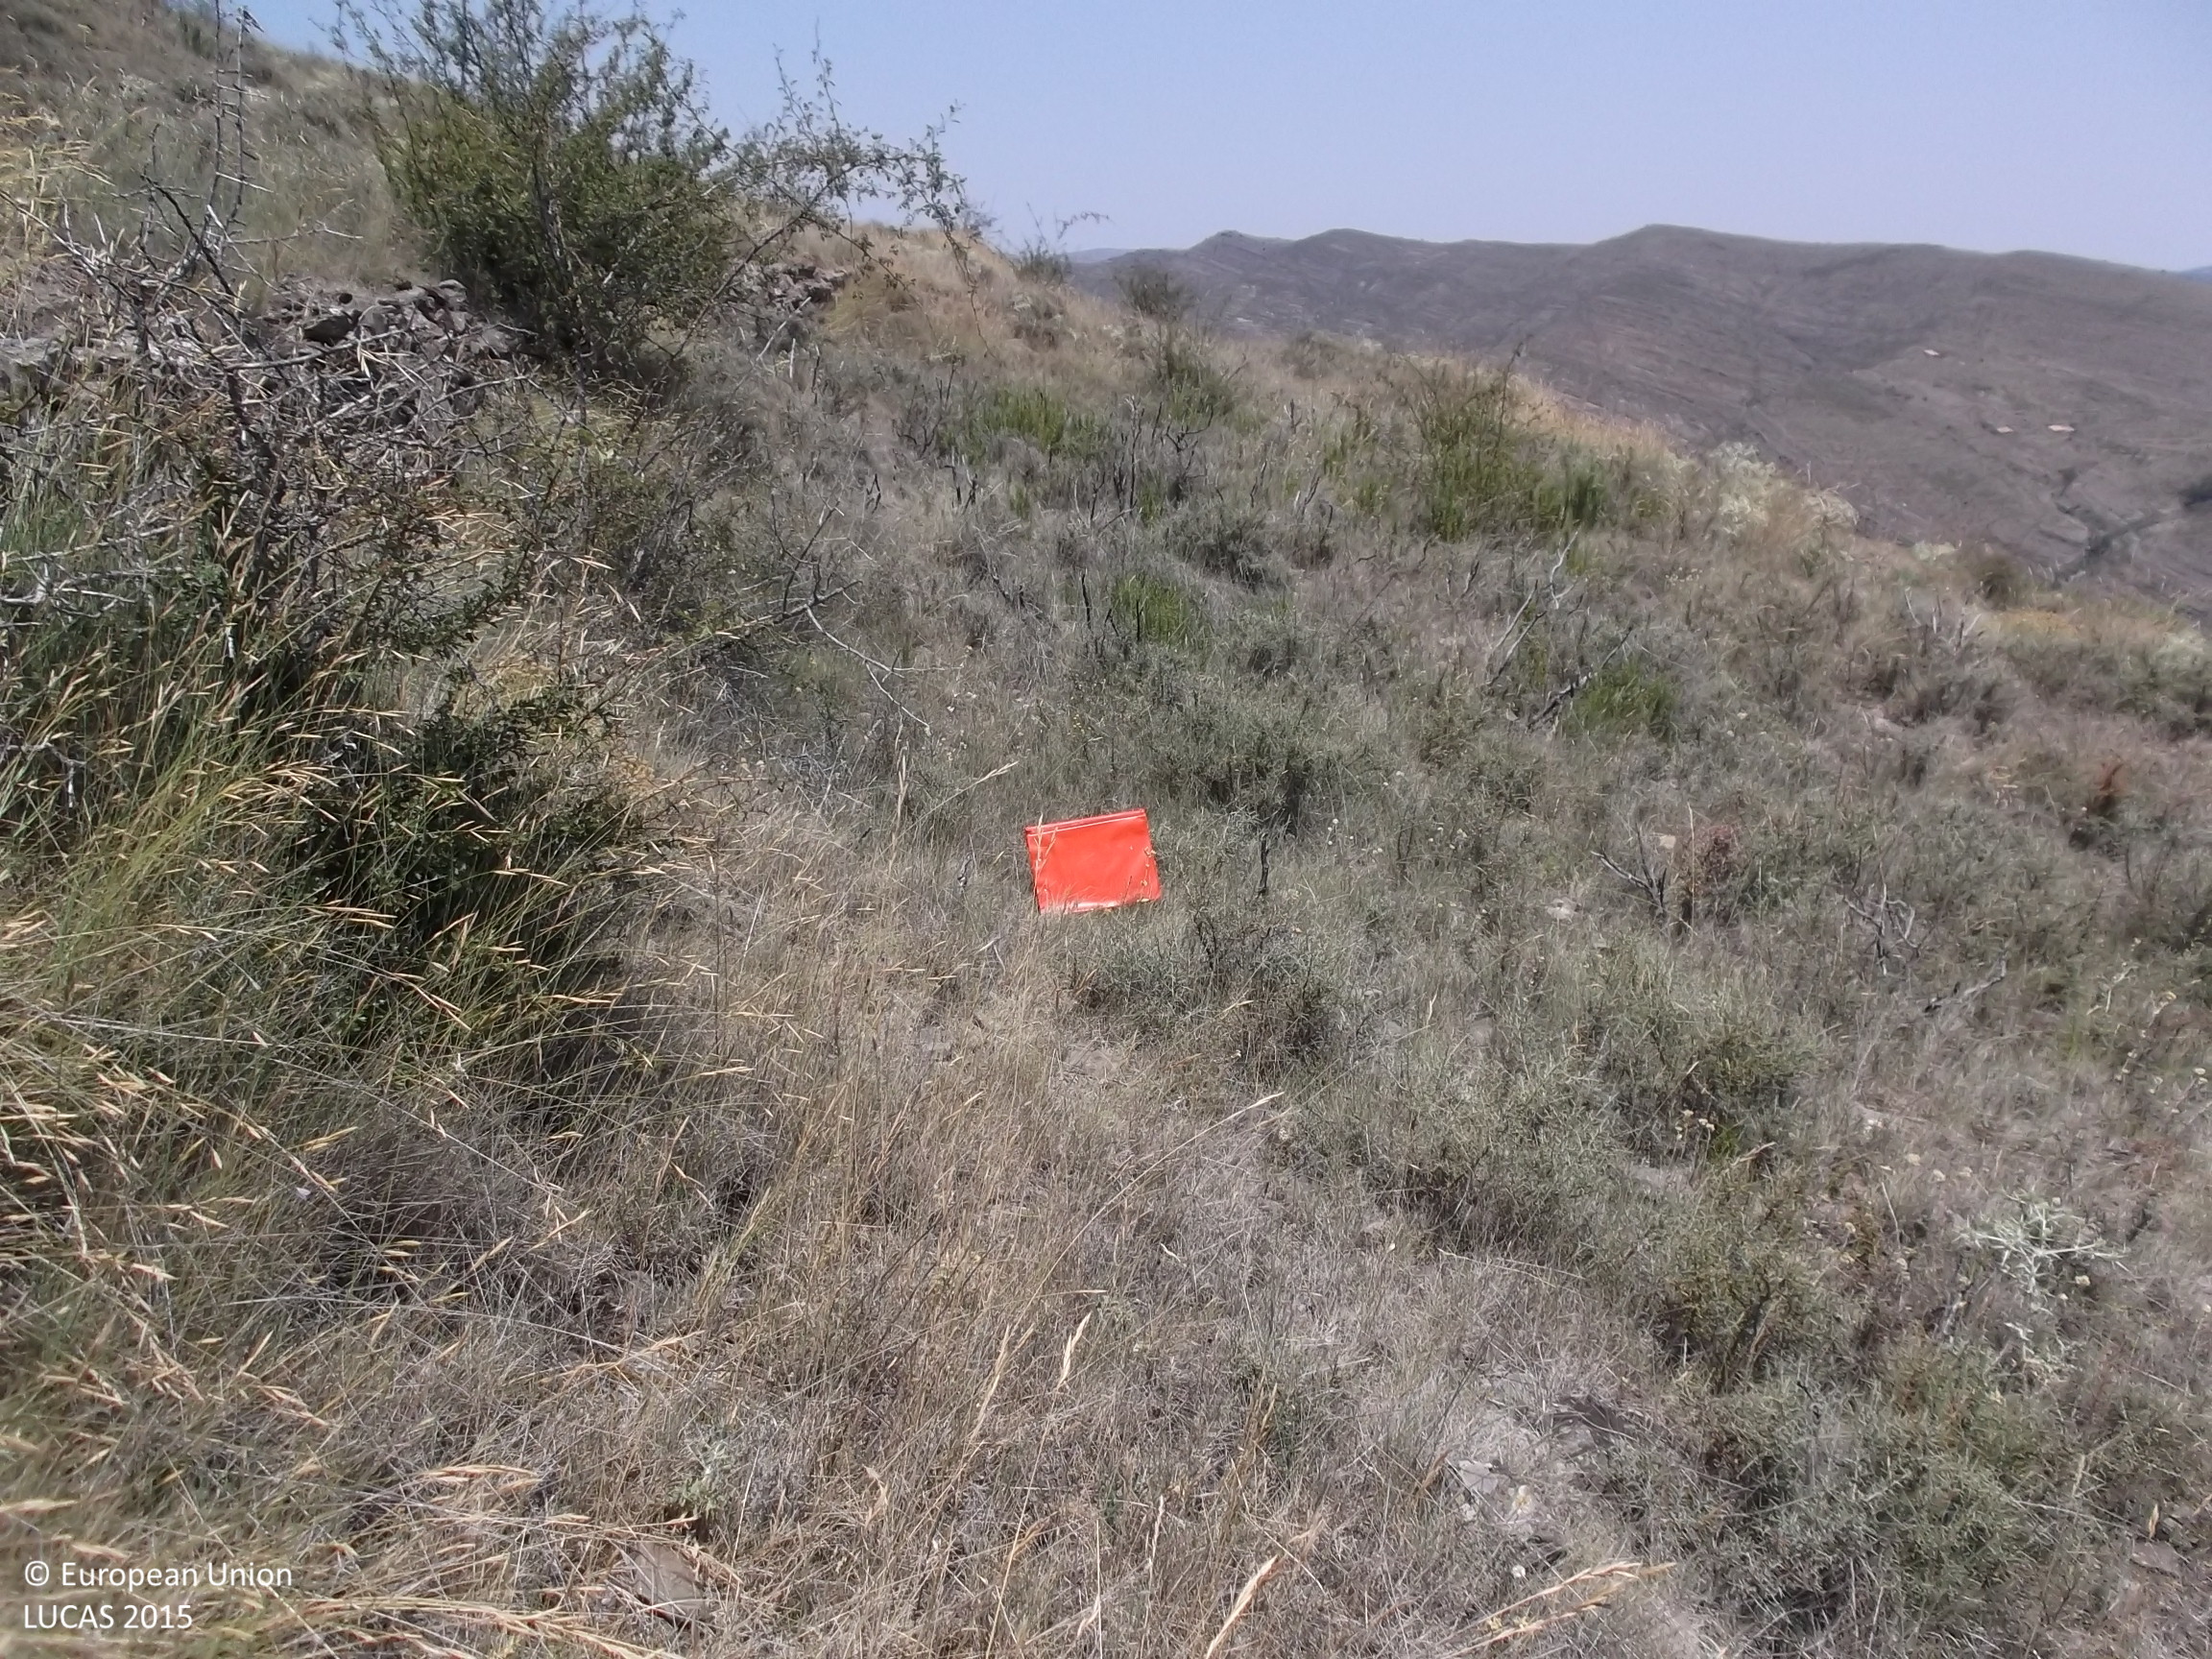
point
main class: Shrubland
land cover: Shrubland without tree cover
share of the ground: 50 - 75 %
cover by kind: shrubs 60 %, herbaceous plants 30 %, unconsolidated bare surface 10 %
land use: Agriculture (excluding fallow land and kitchen gardens)
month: July
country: ES
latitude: 42.0703
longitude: -2.1111
